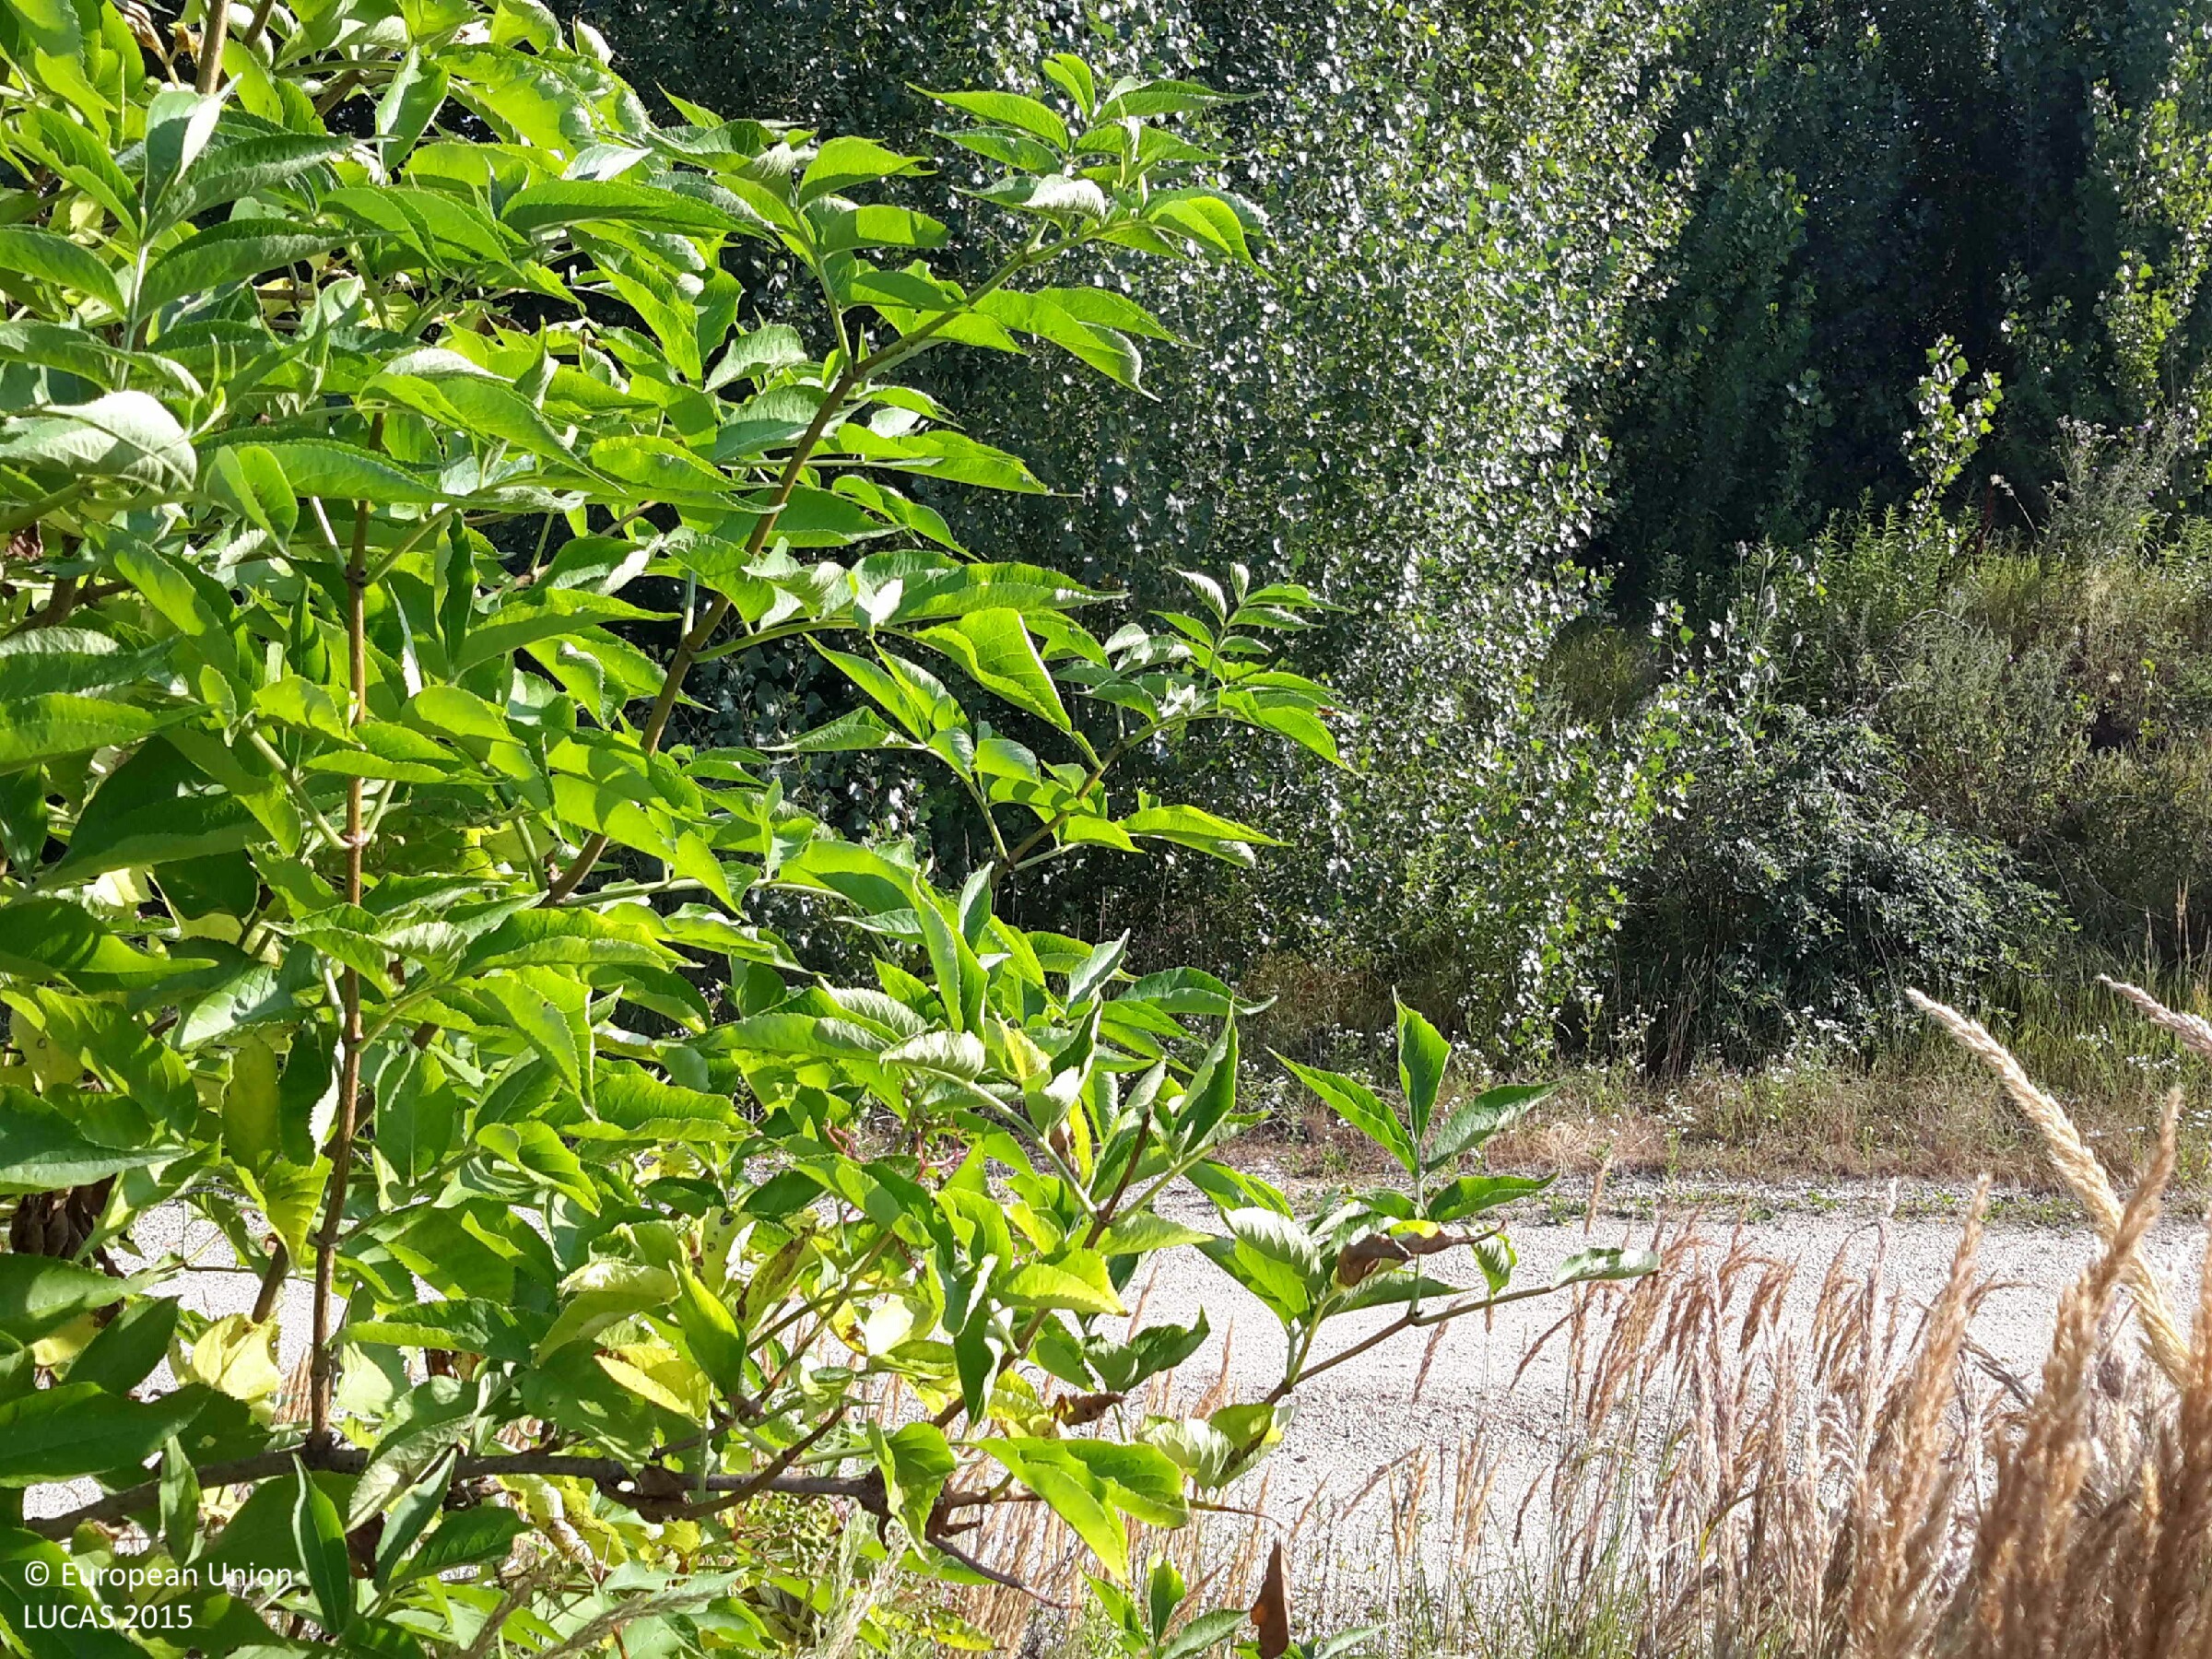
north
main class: Grassland
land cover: Grassland with sparse tree/shrub cover
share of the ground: > 75 %
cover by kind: herbaceous plants 90 %, broadleaved forest trees 5 %, shrubs 5 %
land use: Semi-natural and natural areas not in use
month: July
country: HU
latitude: 47.5437
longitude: 17.0878
